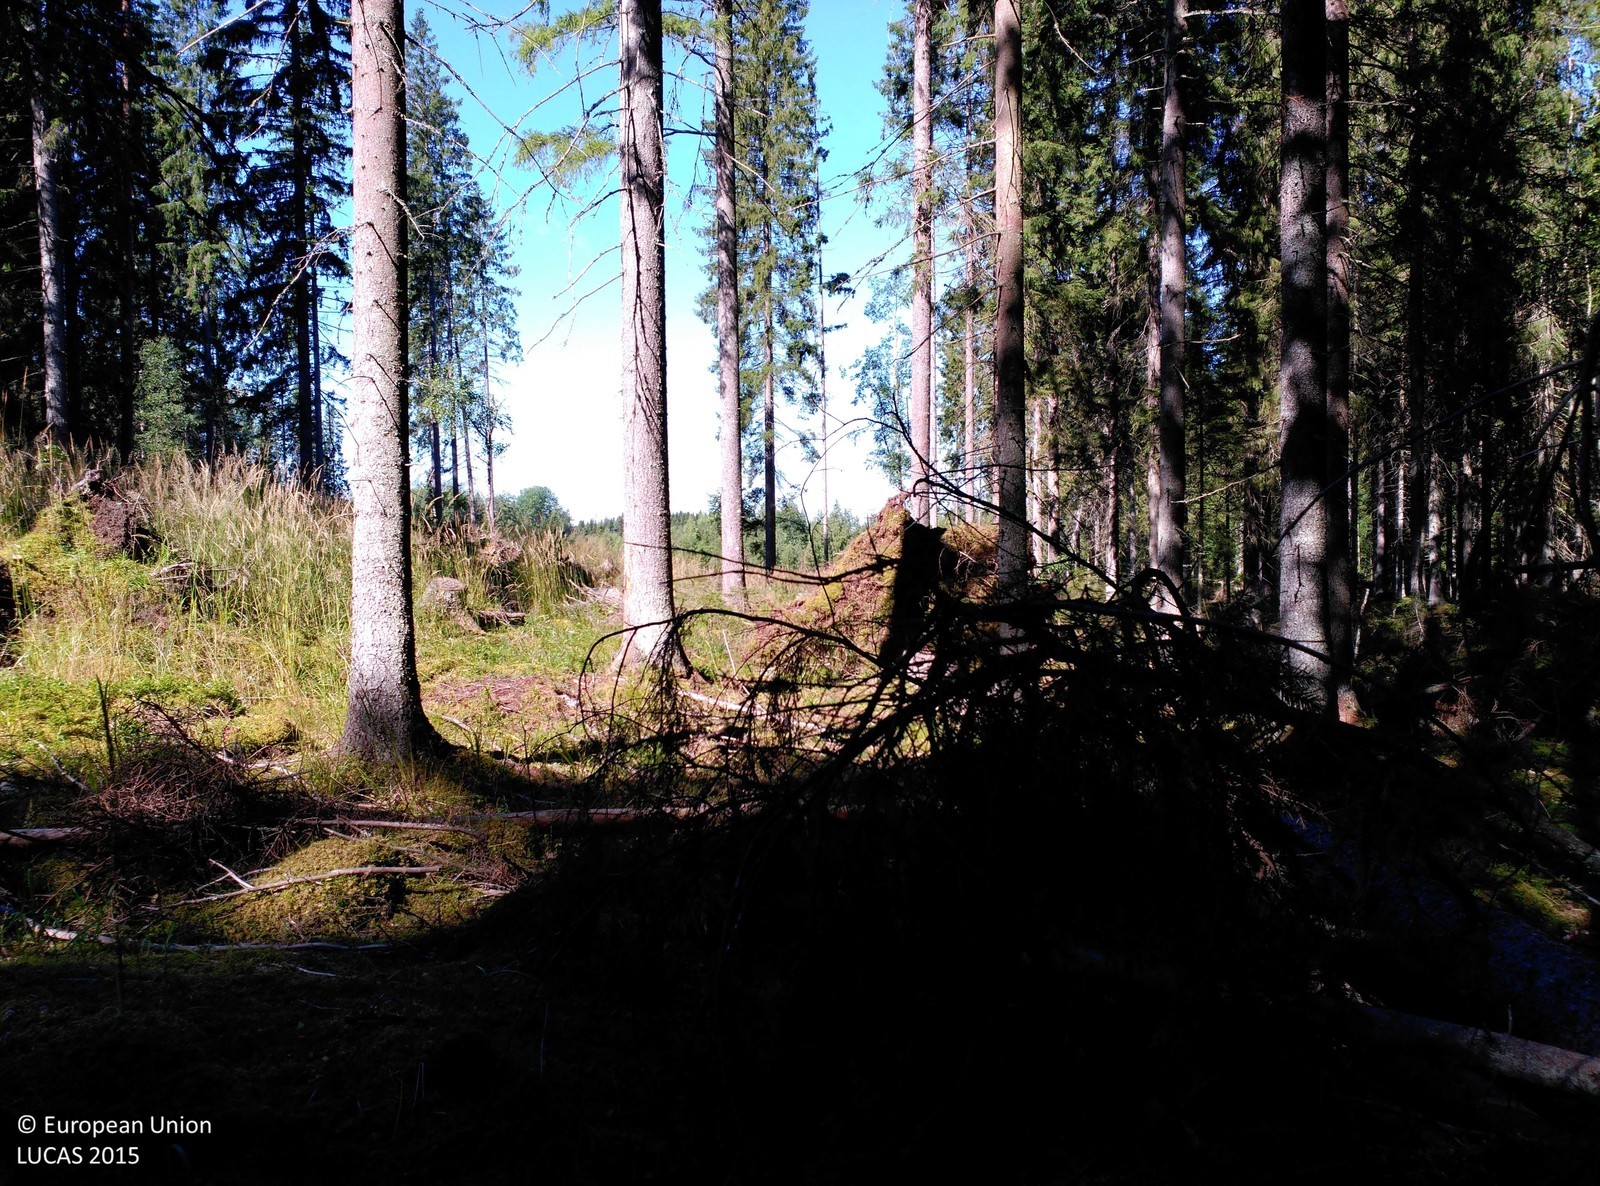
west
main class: Woodland
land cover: Spruce dominated coniferous woodland
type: hemiboreal forest and nemoral coniferous forest and mixed broadleaved-coniferous forest
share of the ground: 50 - 75 %
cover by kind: coniferous forest trees 65 %, lichens and mosses 25 %, shrubs 10 %
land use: Forestry
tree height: > 5 m
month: August
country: FI
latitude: 61.0506
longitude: 22.8697
